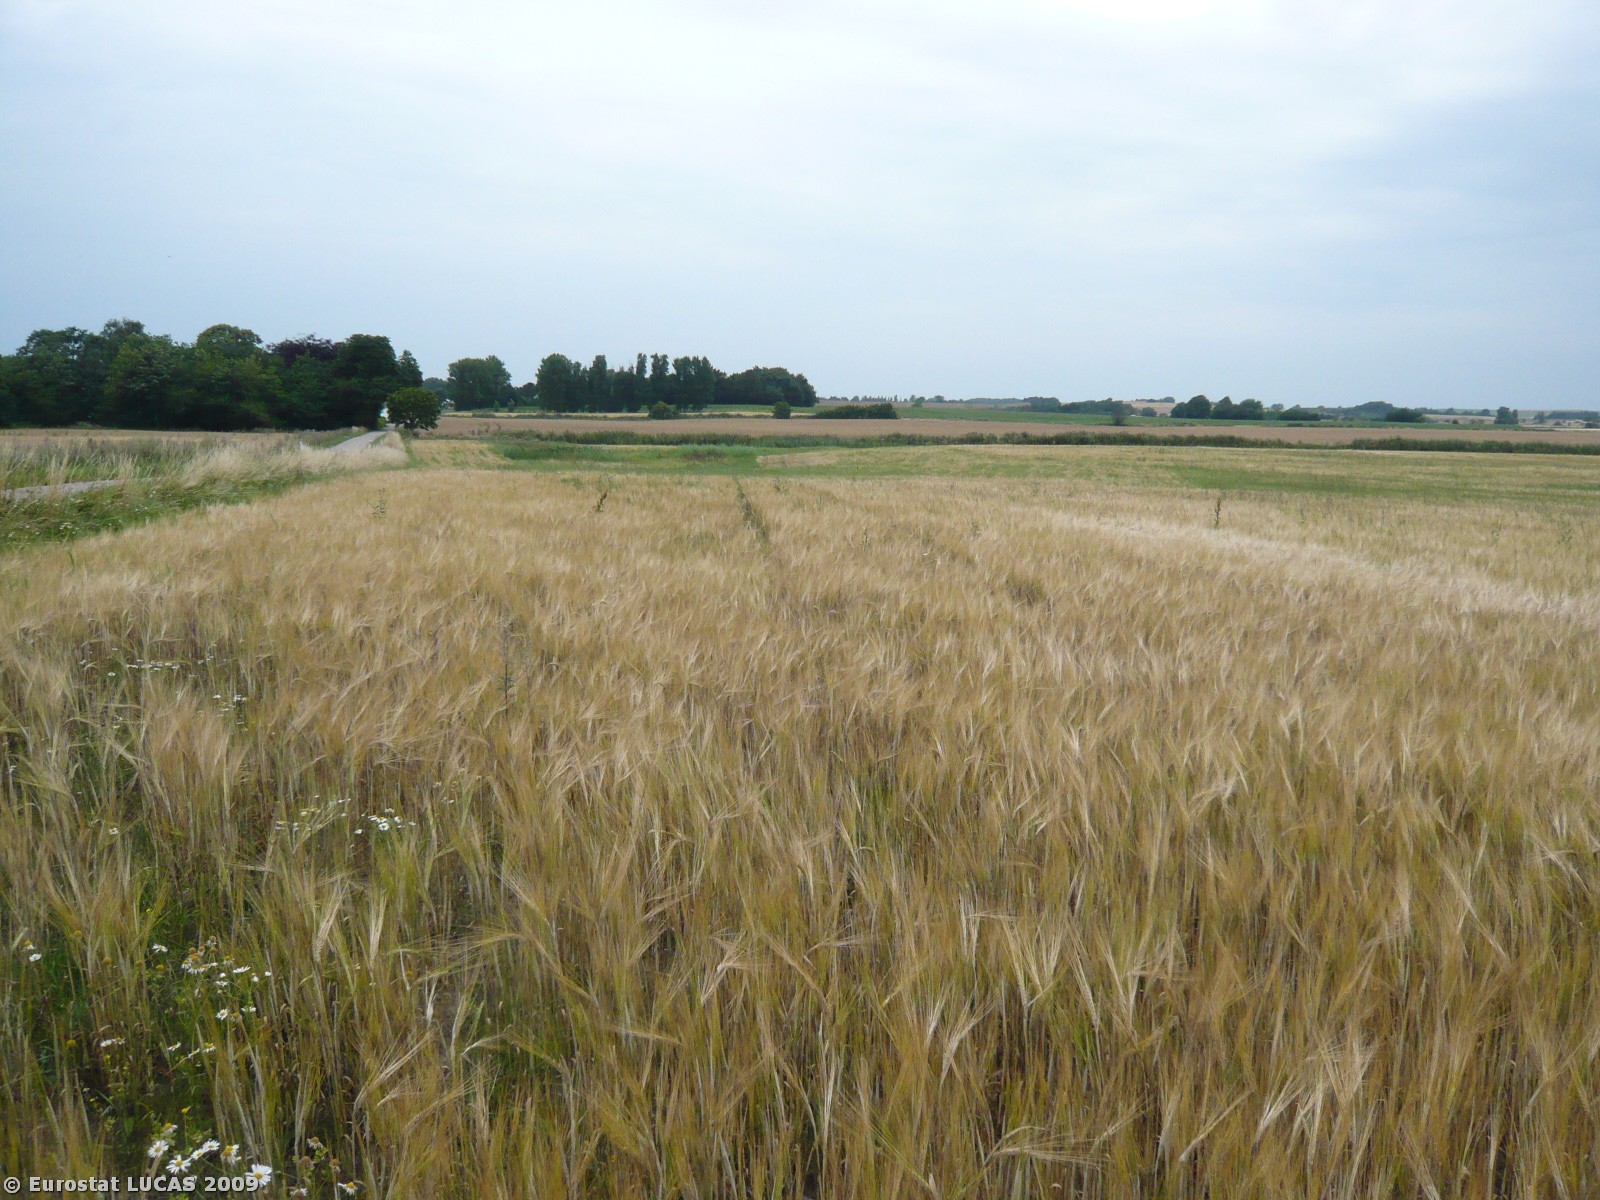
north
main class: Cropland
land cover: Barley
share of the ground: > 75 %
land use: Agriculture (excluding fallow land and kitchen gardens)
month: July
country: DK
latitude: 55.8830
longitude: 12.0923
